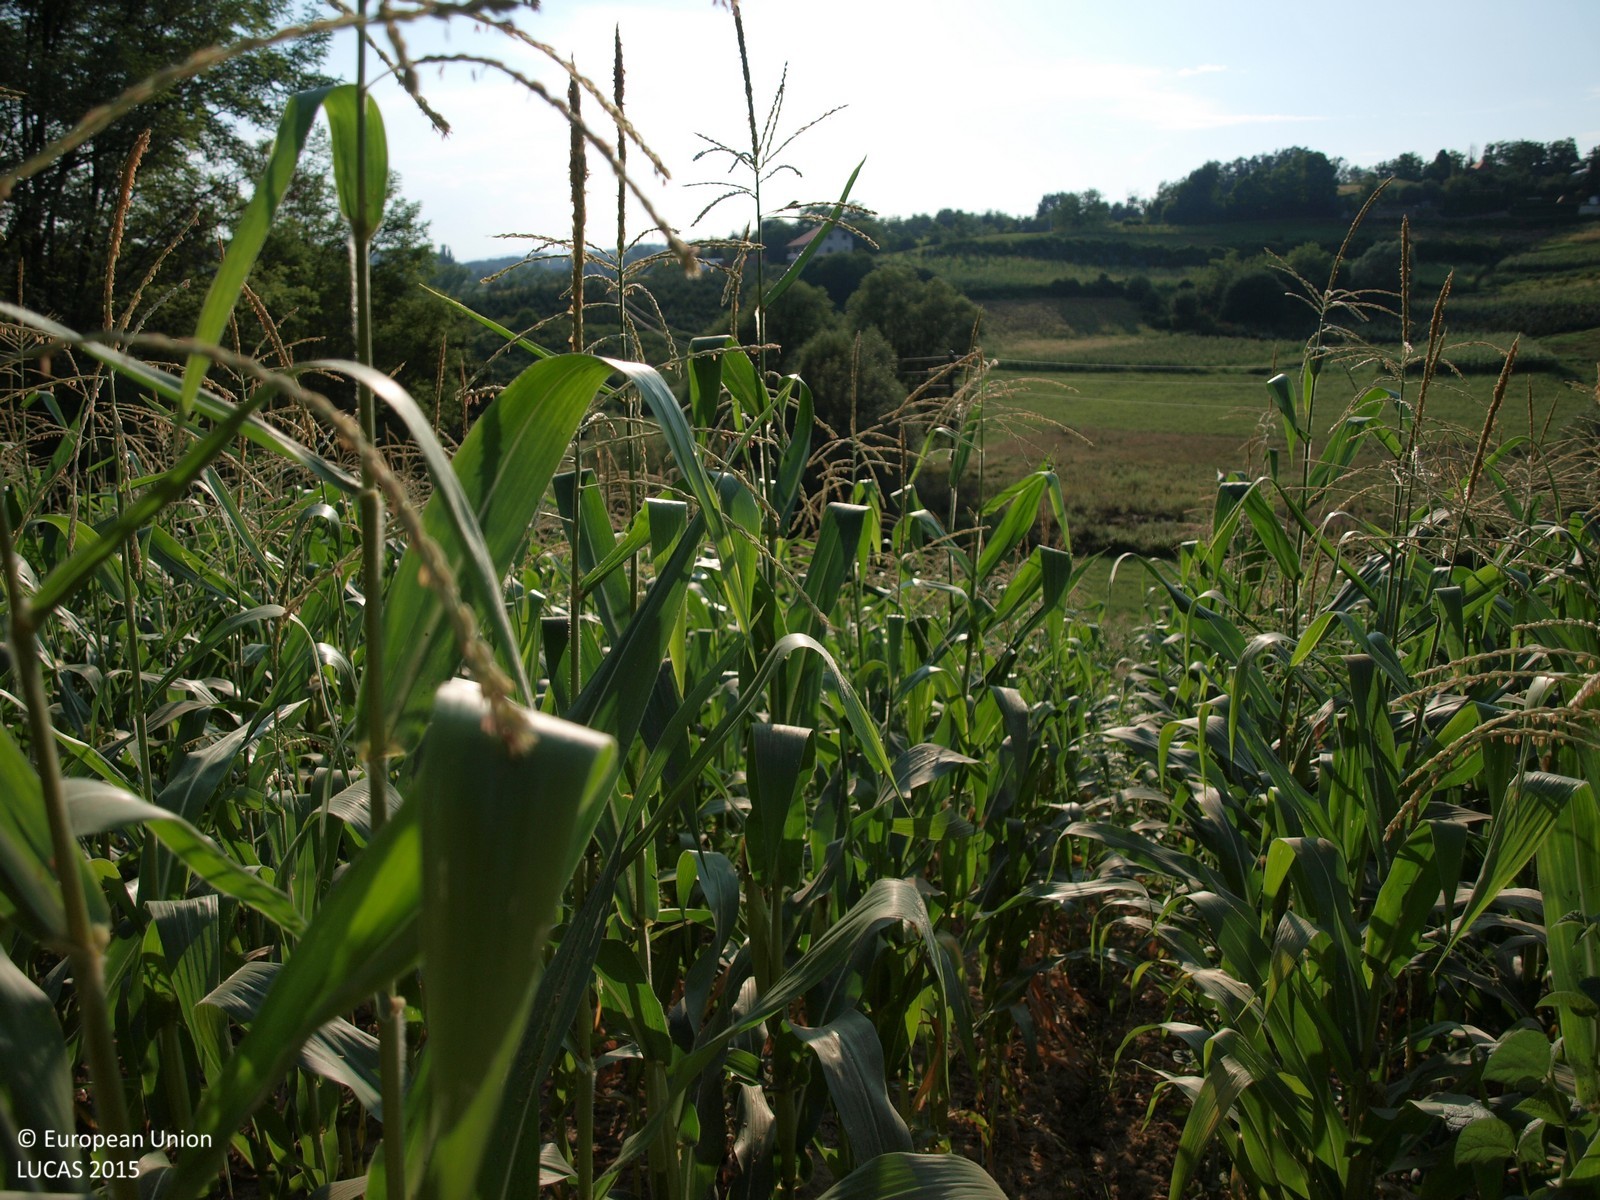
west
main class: Cropland
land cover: Maize
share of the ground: > 75 %
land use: Agriculture (excluding fallow land and kitchen gardens)
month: July
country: HR
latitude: 45.9184
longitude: 16.2005
